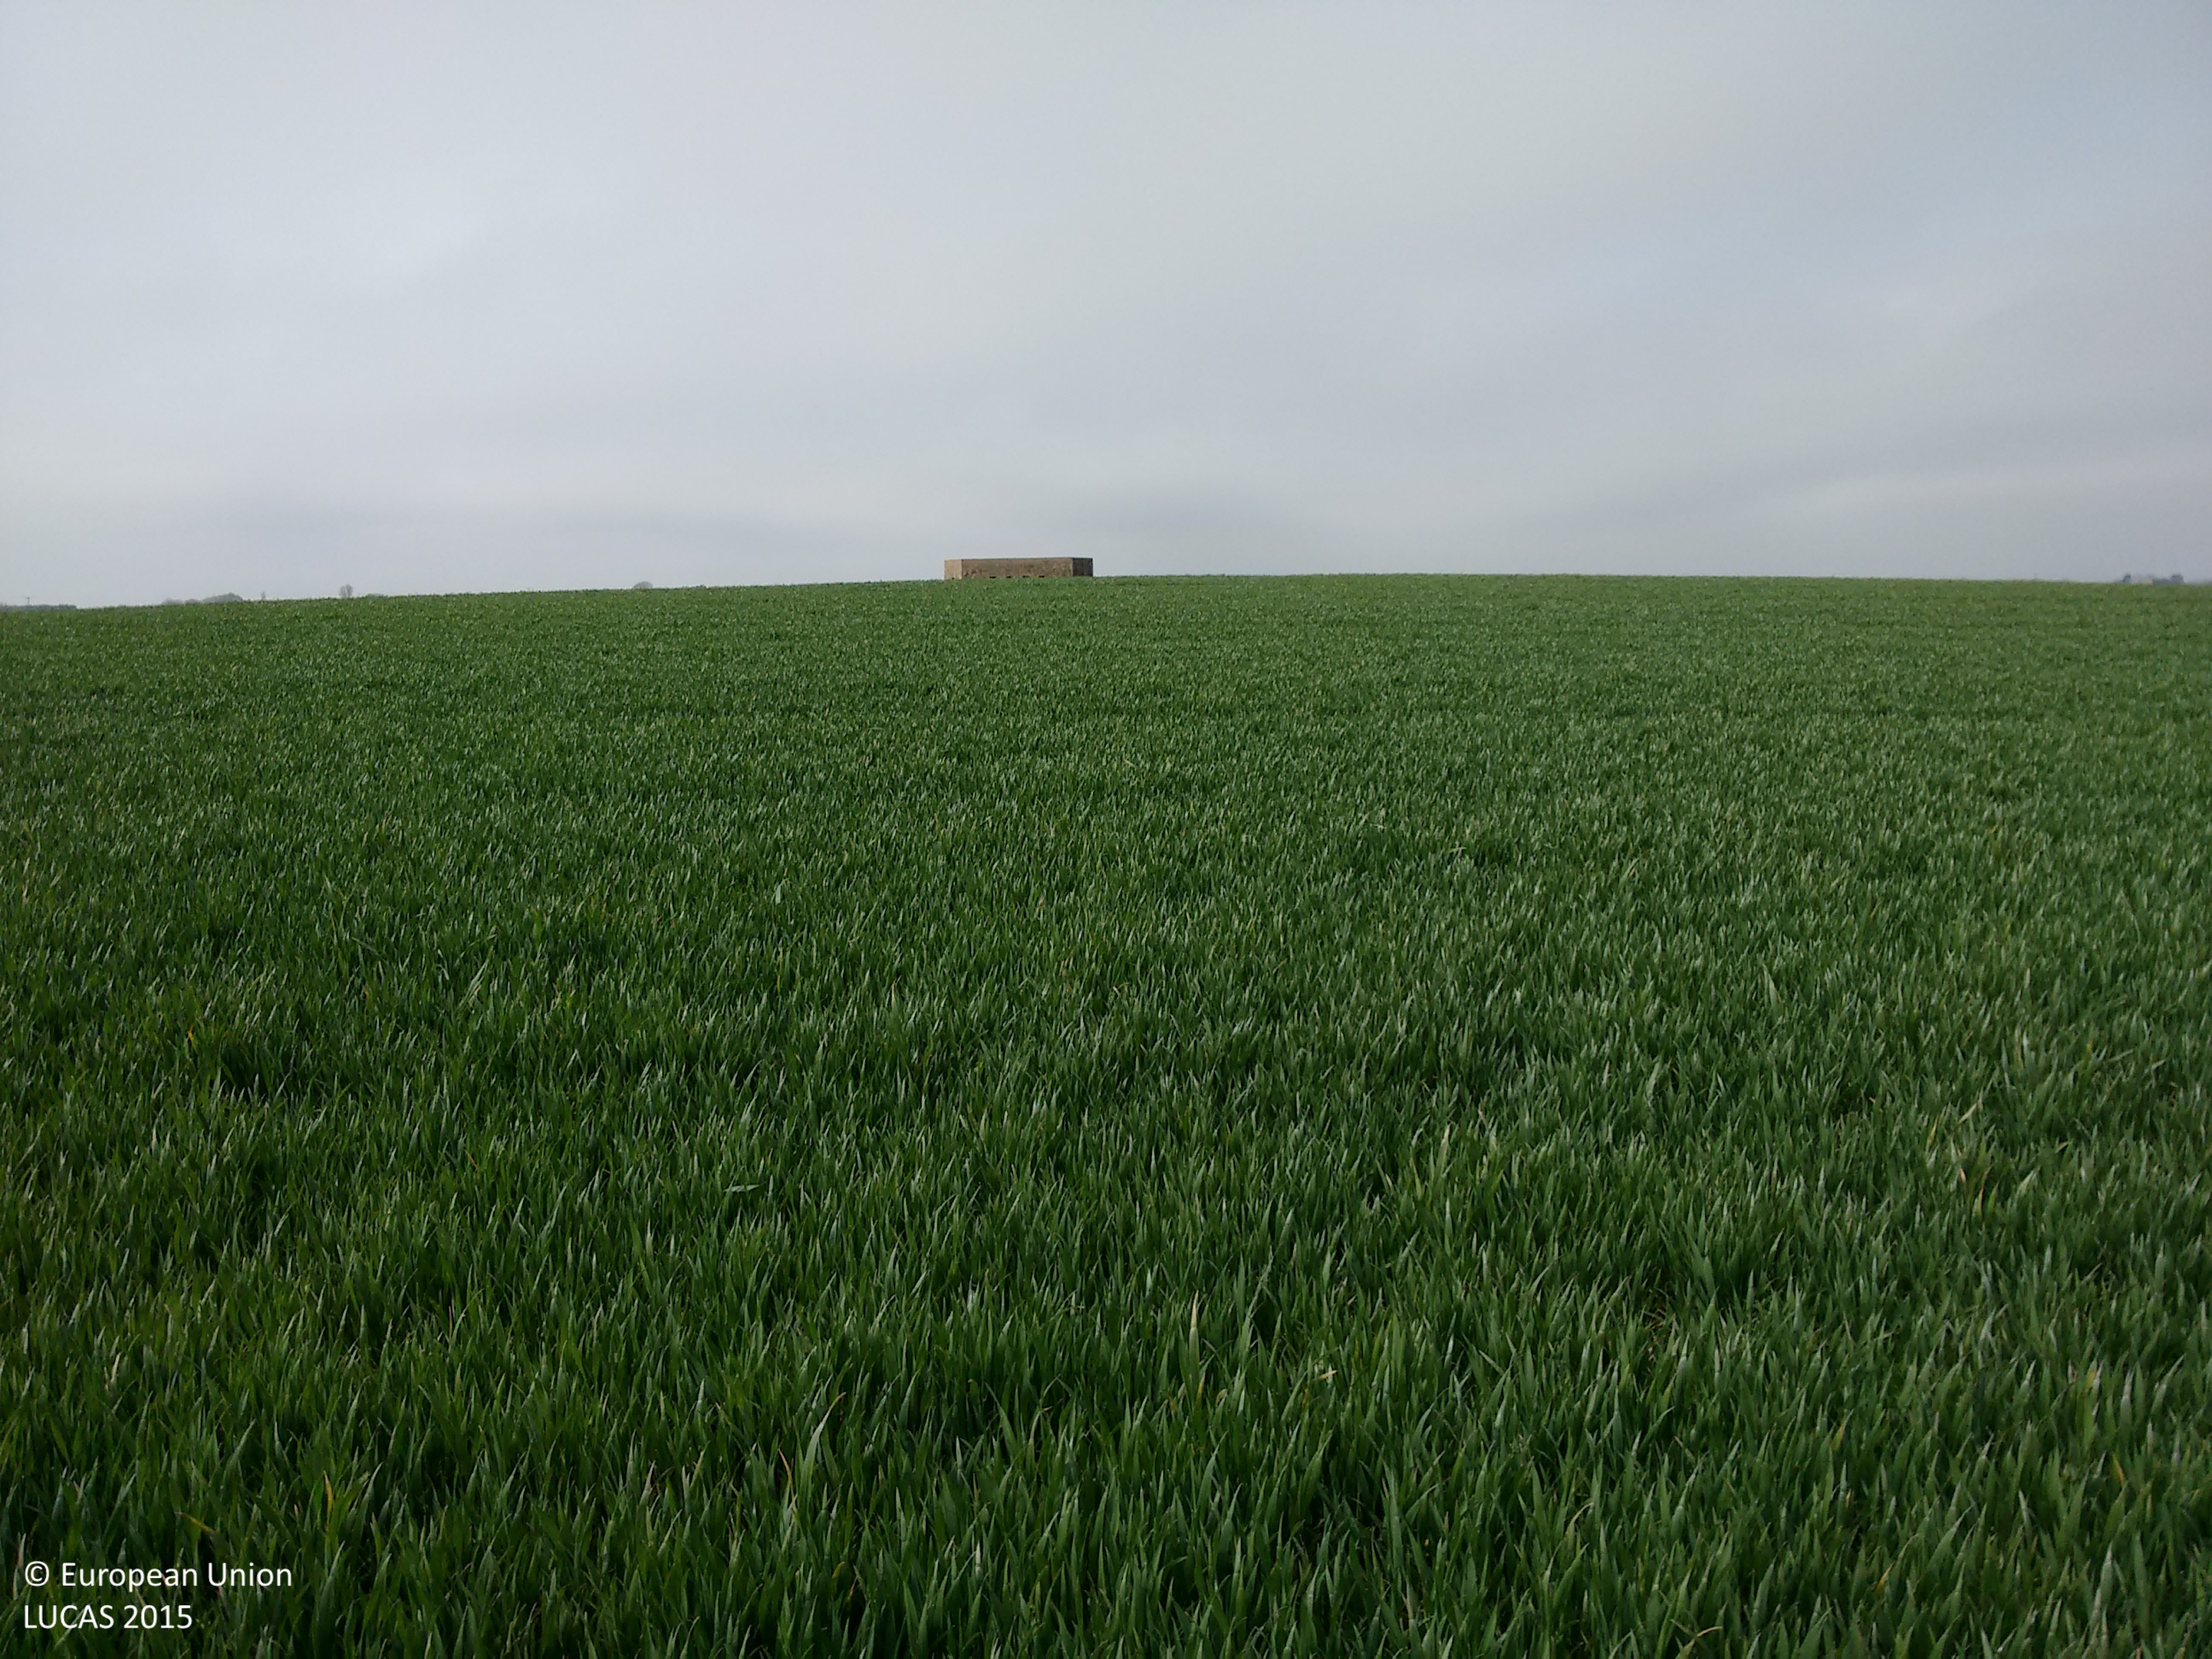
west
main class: Cropland
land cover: Common wheat
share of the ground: > 75 %
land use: Agriculture (excluding fallow land and kitchen gardens)
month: May
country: GB
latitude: 53.9848
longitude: -0.2051
